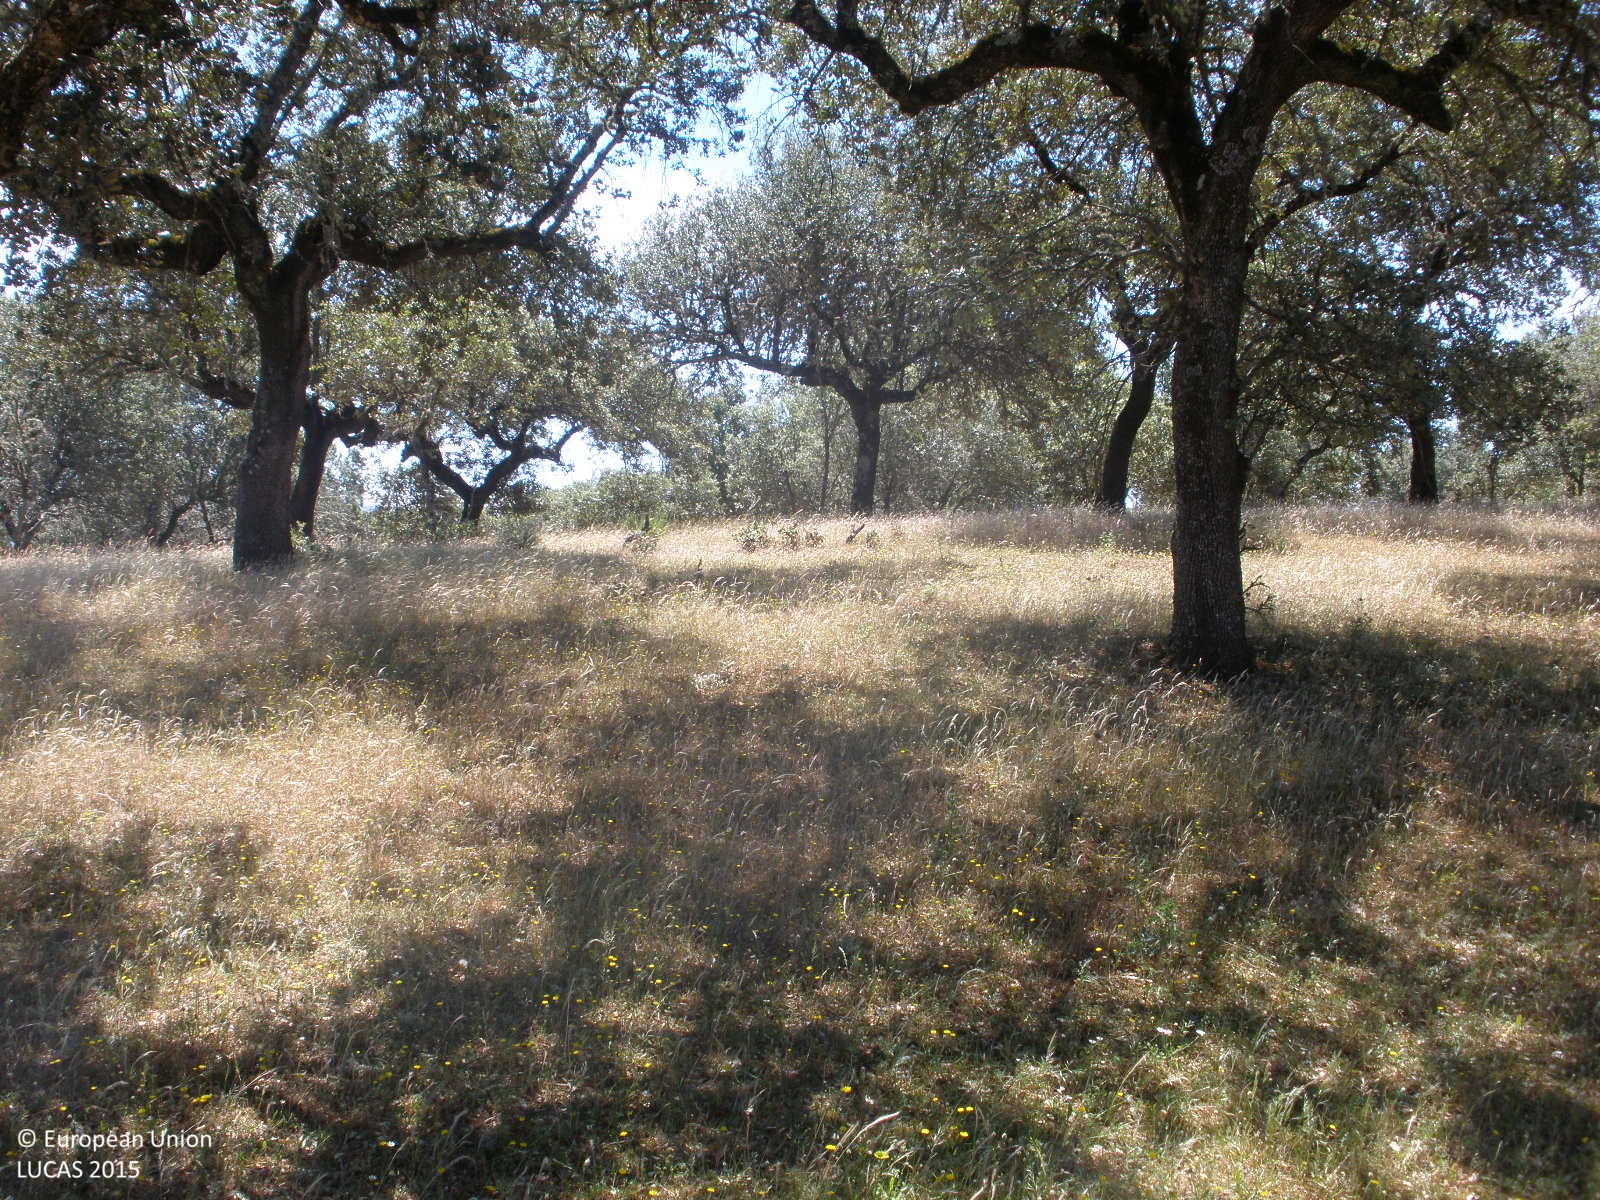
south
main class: Woodland
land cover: Broadleaved woodland
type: broadleaved evergreen forest
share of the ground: > 75 %
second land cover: Grassland without tree/shrub cover
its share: > 75 %
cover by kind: broadleaved forest trees 70 %, herbaceous plants 30 %
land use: Forestry
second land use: Agriculture (excluding fallow land and kitchen gardens)
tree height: > 5 m
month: May
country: ES
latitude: 40.2038
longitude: -6.0631
